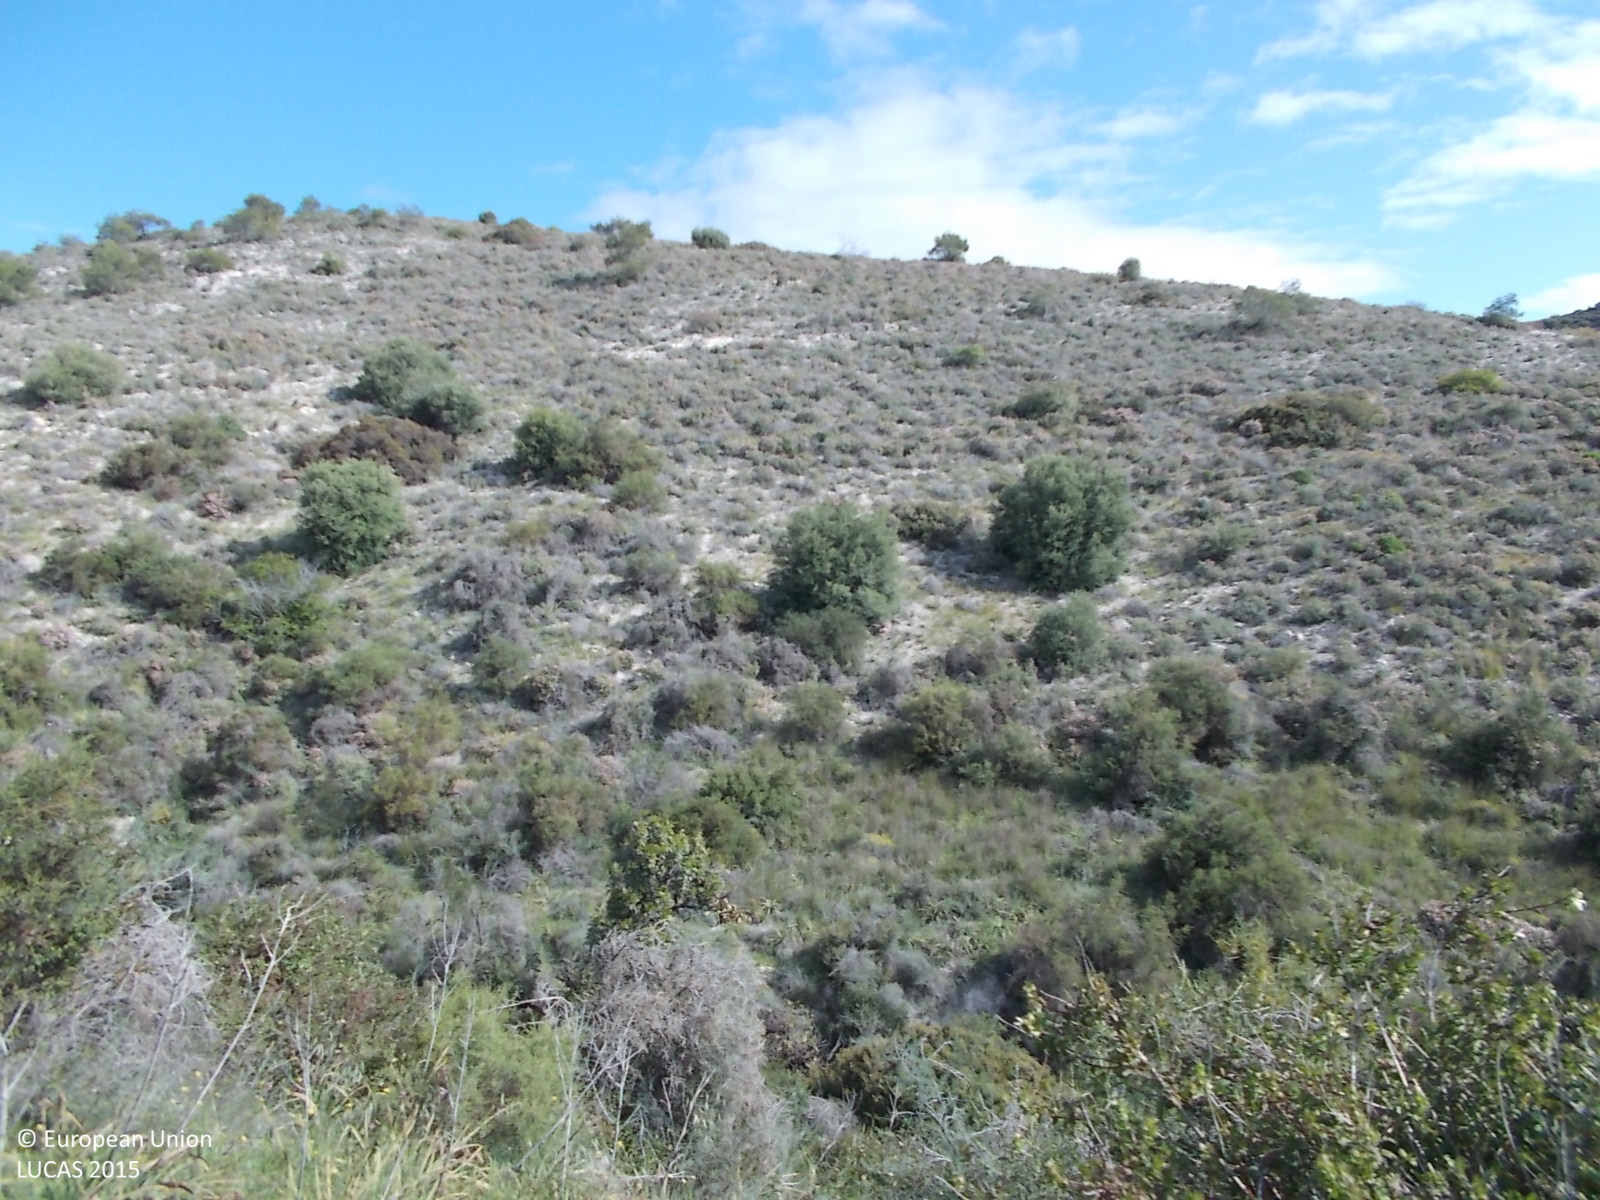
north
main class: Shrubland
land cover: Shrubland without tree cover
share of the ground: > 75 %
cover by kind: shrubs 90 %, herbaceous plants 10 %
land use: Semi-natural and natural areas not in use
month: April
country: CY
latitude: 34.8761
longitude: 33.4808
